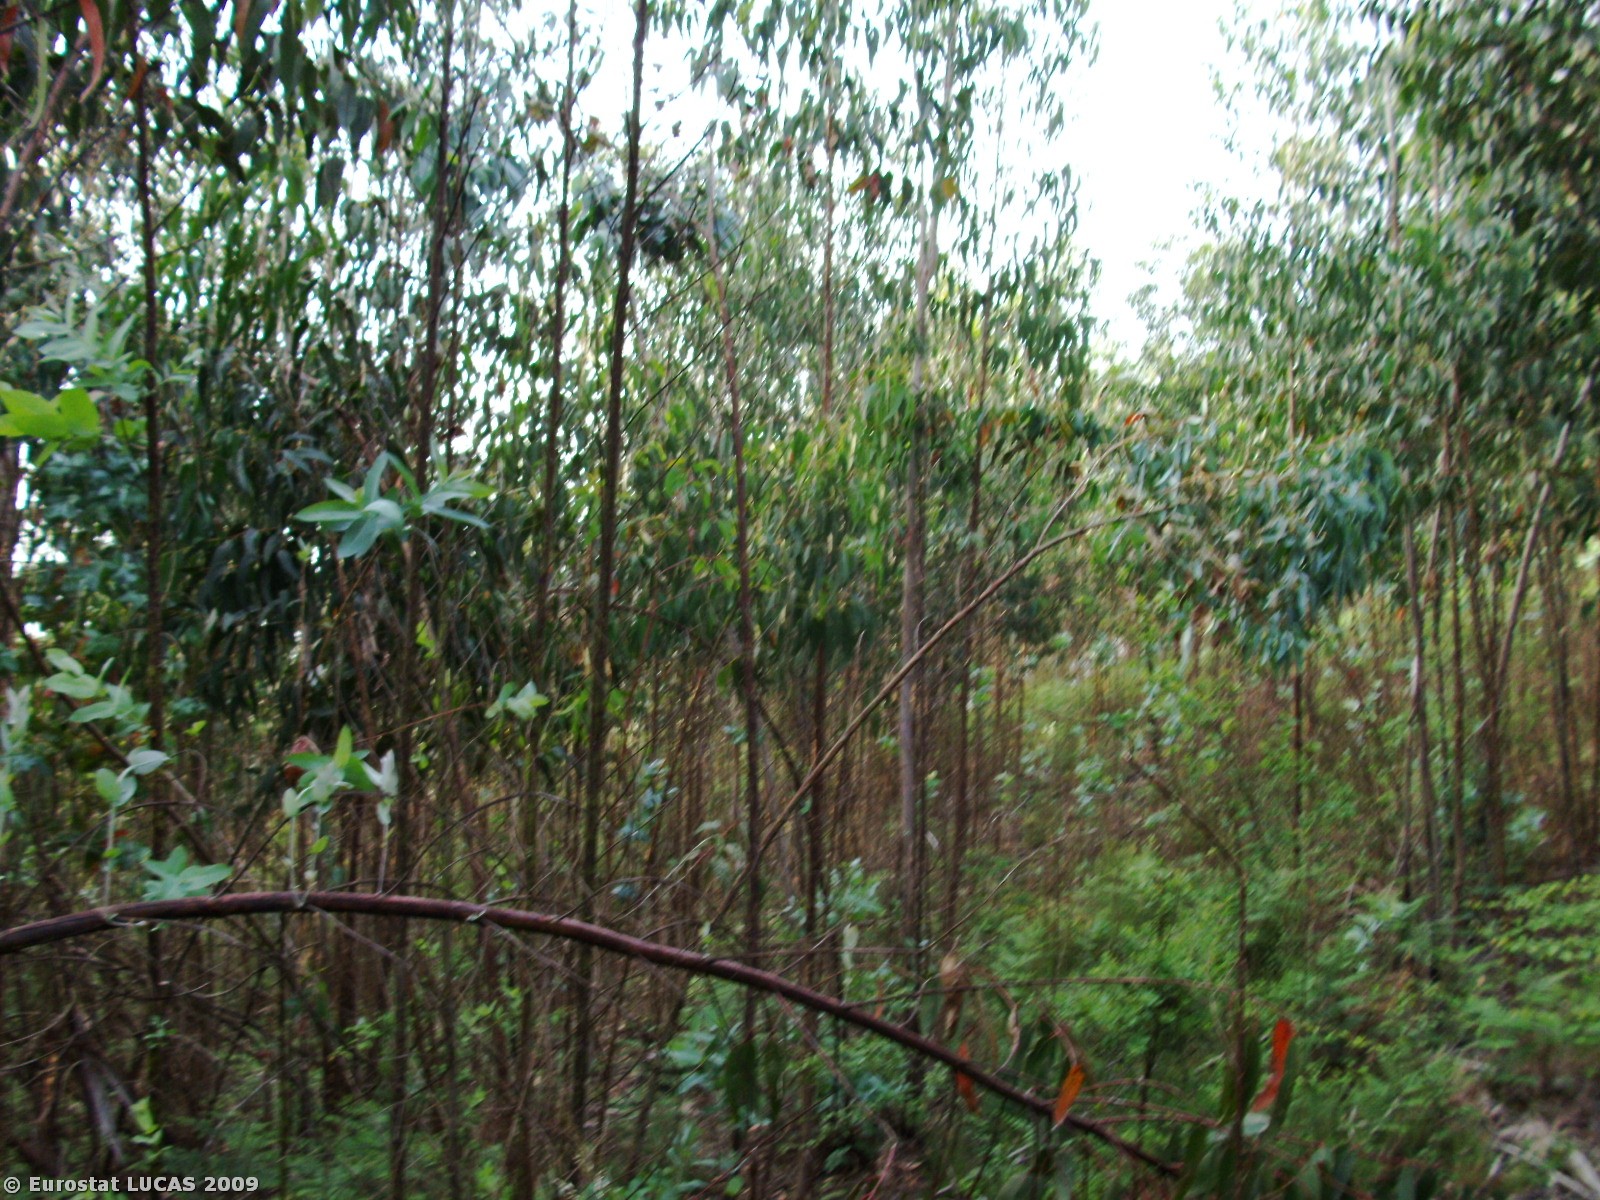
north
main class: Woodland
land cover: Broadleaved woodland
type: plantations and self-sown exotic forest
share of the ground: > 75 %
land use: Forestry
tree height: > 5 m
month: May
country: PT
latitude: 41.0554
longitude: -8.5318
